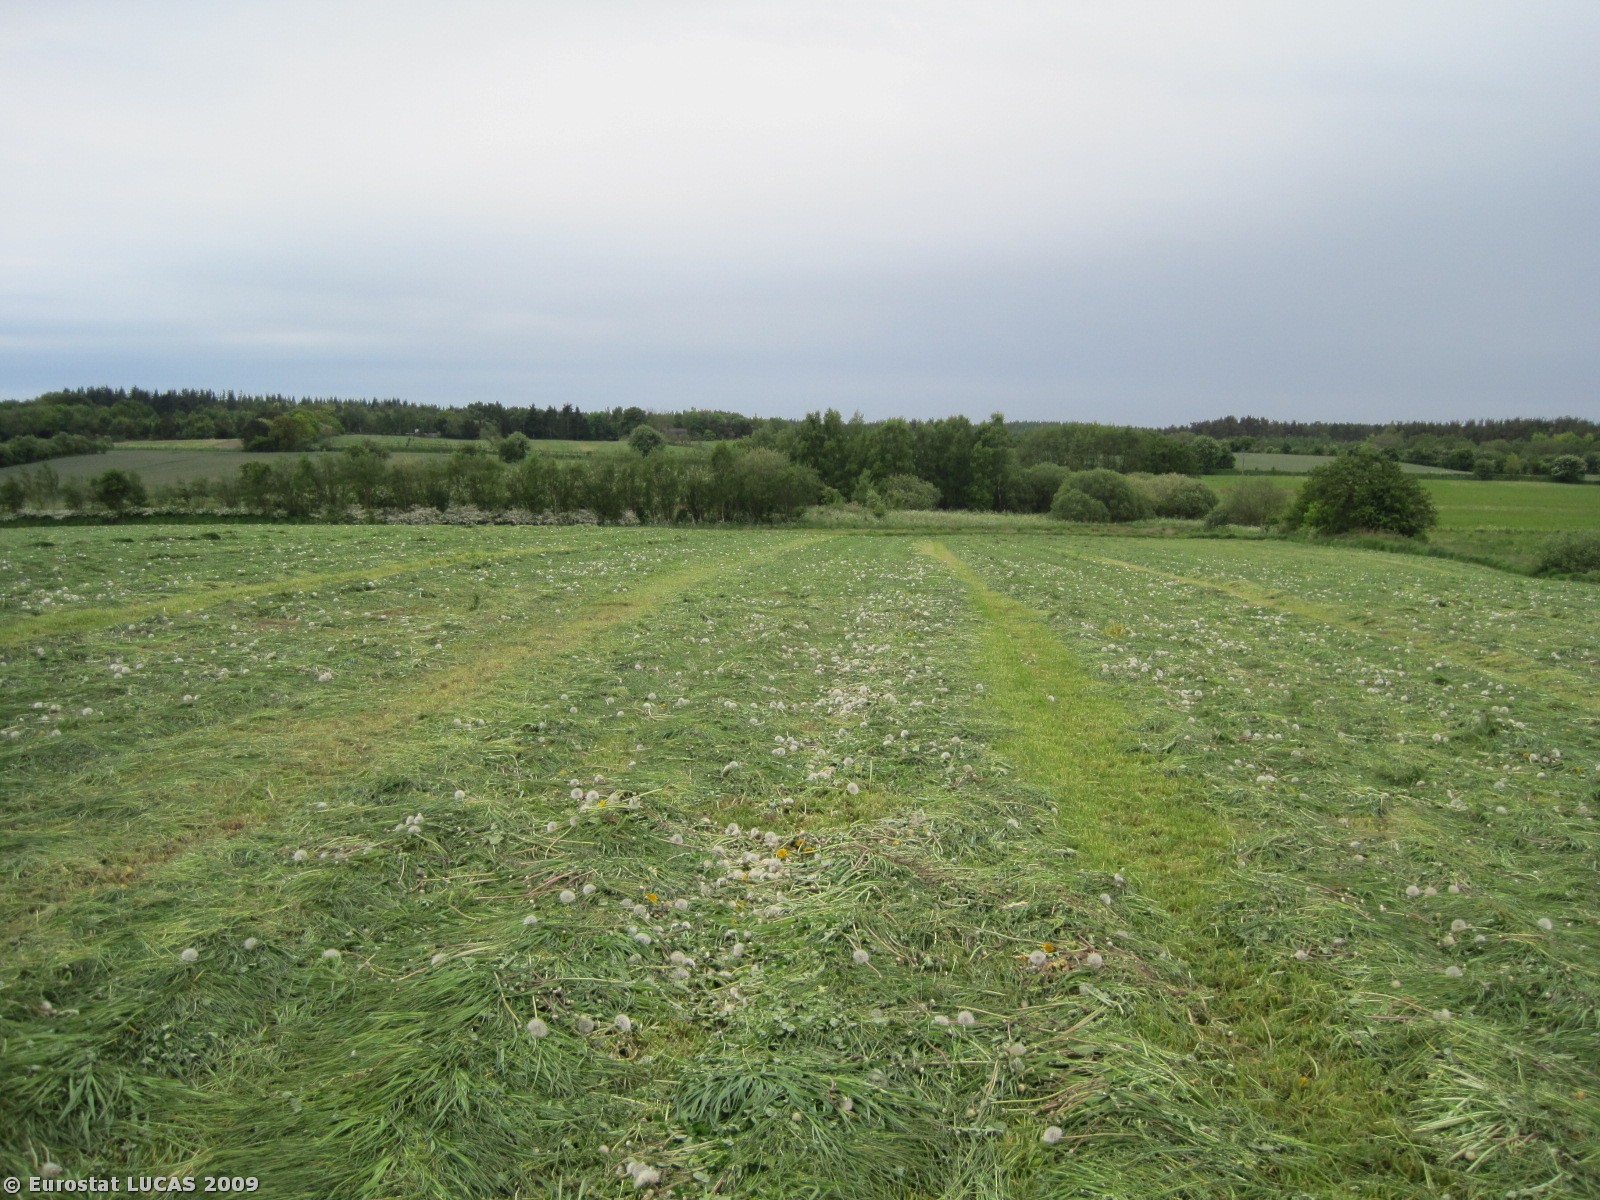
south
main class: Grassland
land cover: Grassland without tree/shrub cover
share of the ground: > 75 %
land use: Agriculture (excluding fallow land and kitchen gardens)
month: May
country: DK
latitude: 56.7450
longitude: 10.0816
